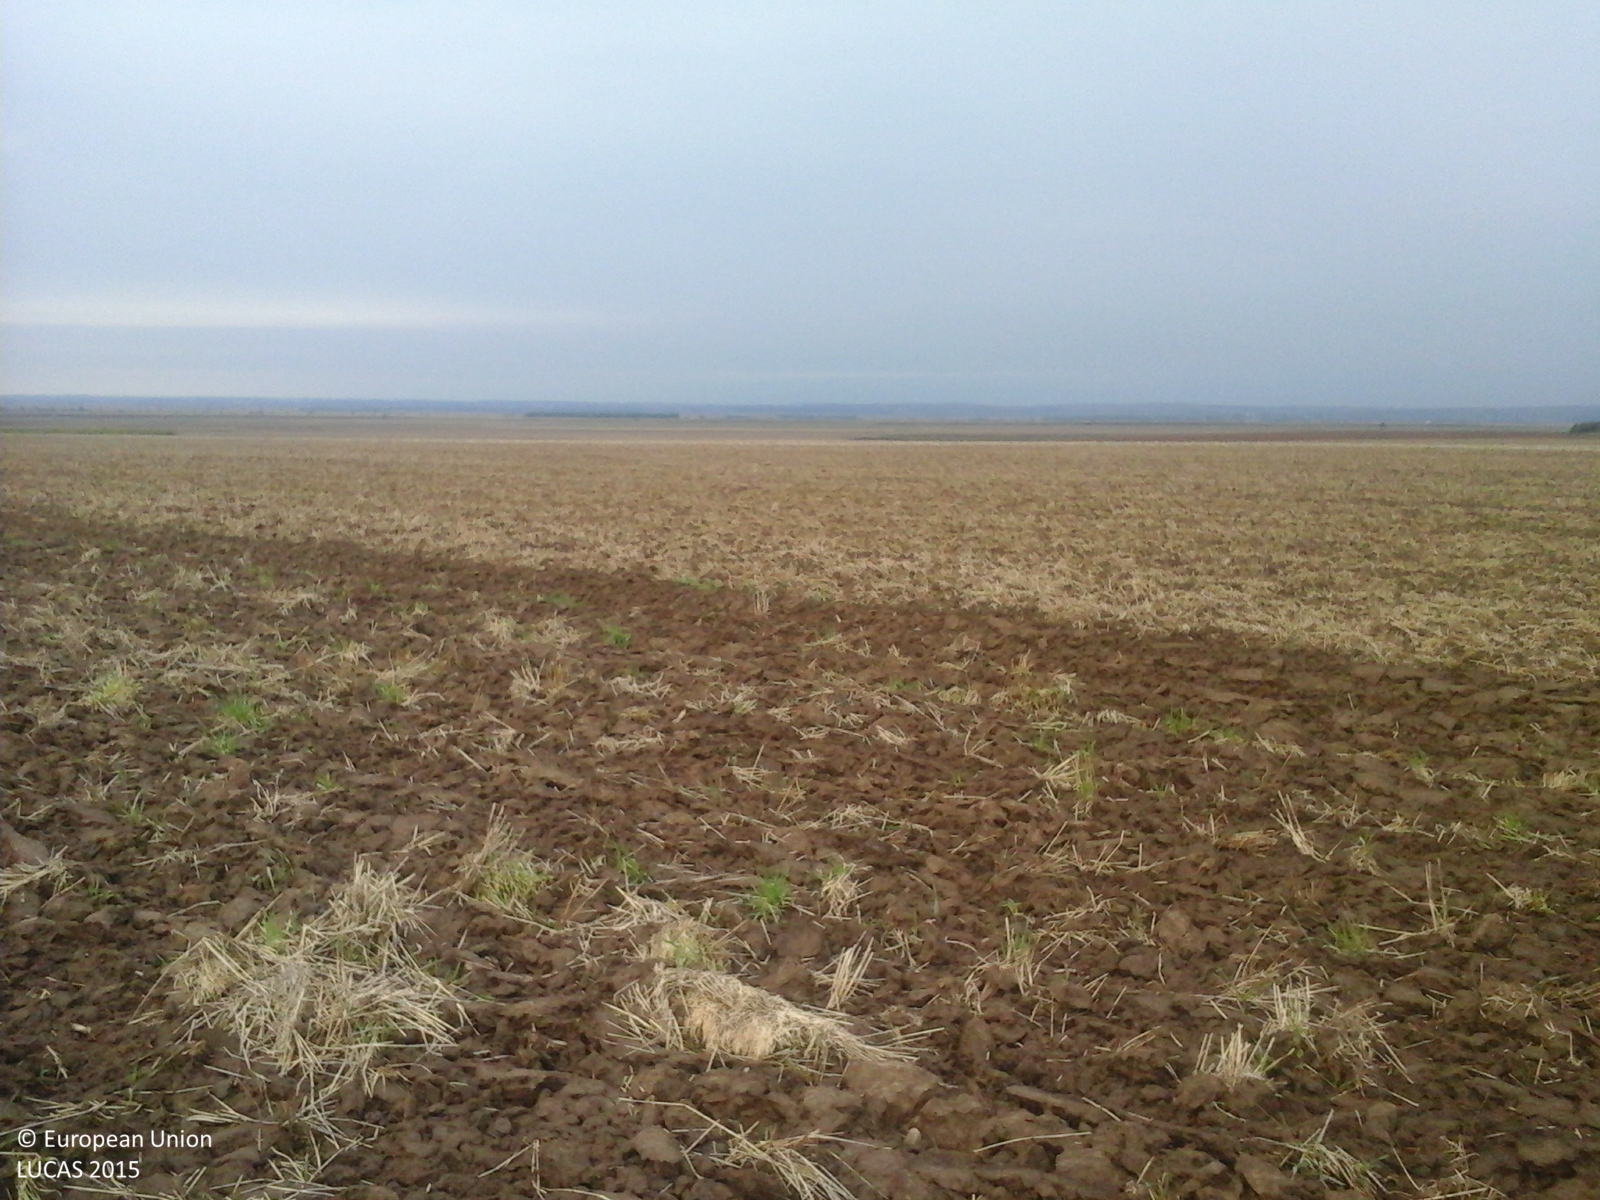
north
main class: Cropland
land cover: Common wheat
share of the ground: < 10 %
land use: Agriculture (excluding fallow land and kitchen gardens)
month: September
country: RO
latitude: 47.1637
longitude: 22.0127
